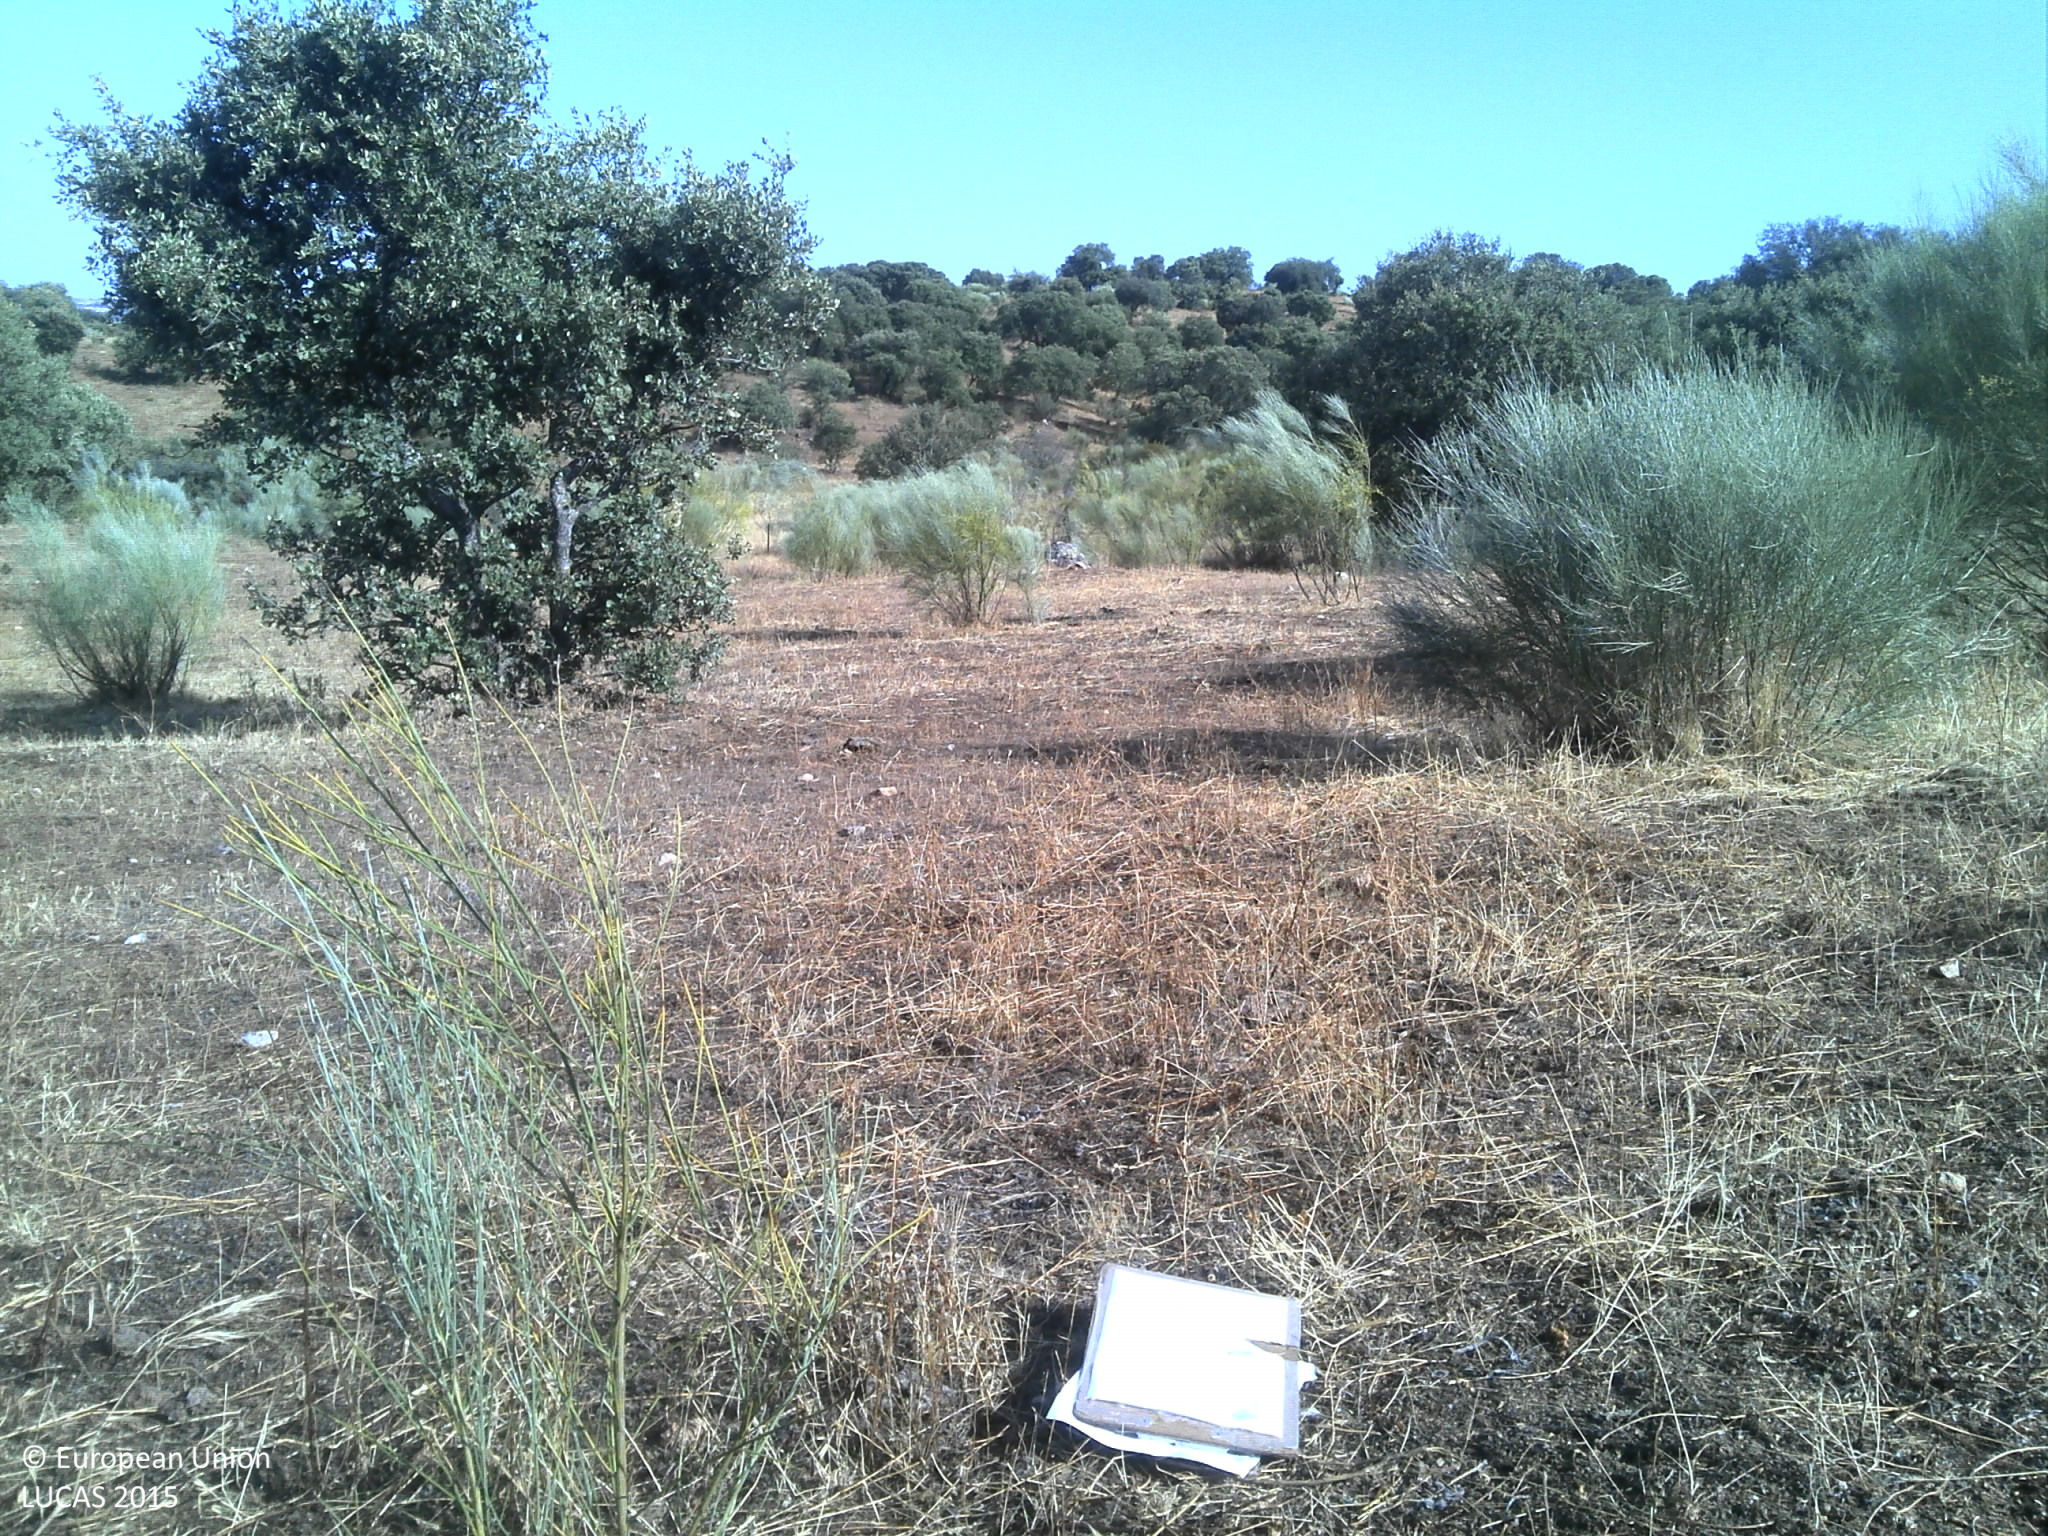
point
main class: Woodland
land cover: Broadleaved woodland
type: broadleaved evergreen forest
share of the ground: 10 - 25 %
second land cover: Grassland without tree/shrub cover
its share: 25 - 50 %
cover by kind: unconsolidated bare surface 45 %, herbaceous plants 30 %, broadleaved forest trees 15 %, shrubs 10 %
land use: Forestry
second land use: Agriculture (excluding fallow land and kitchen gardens)
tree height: > 5 m
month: June
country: PT
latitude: 39.8670
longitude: -6.9568
